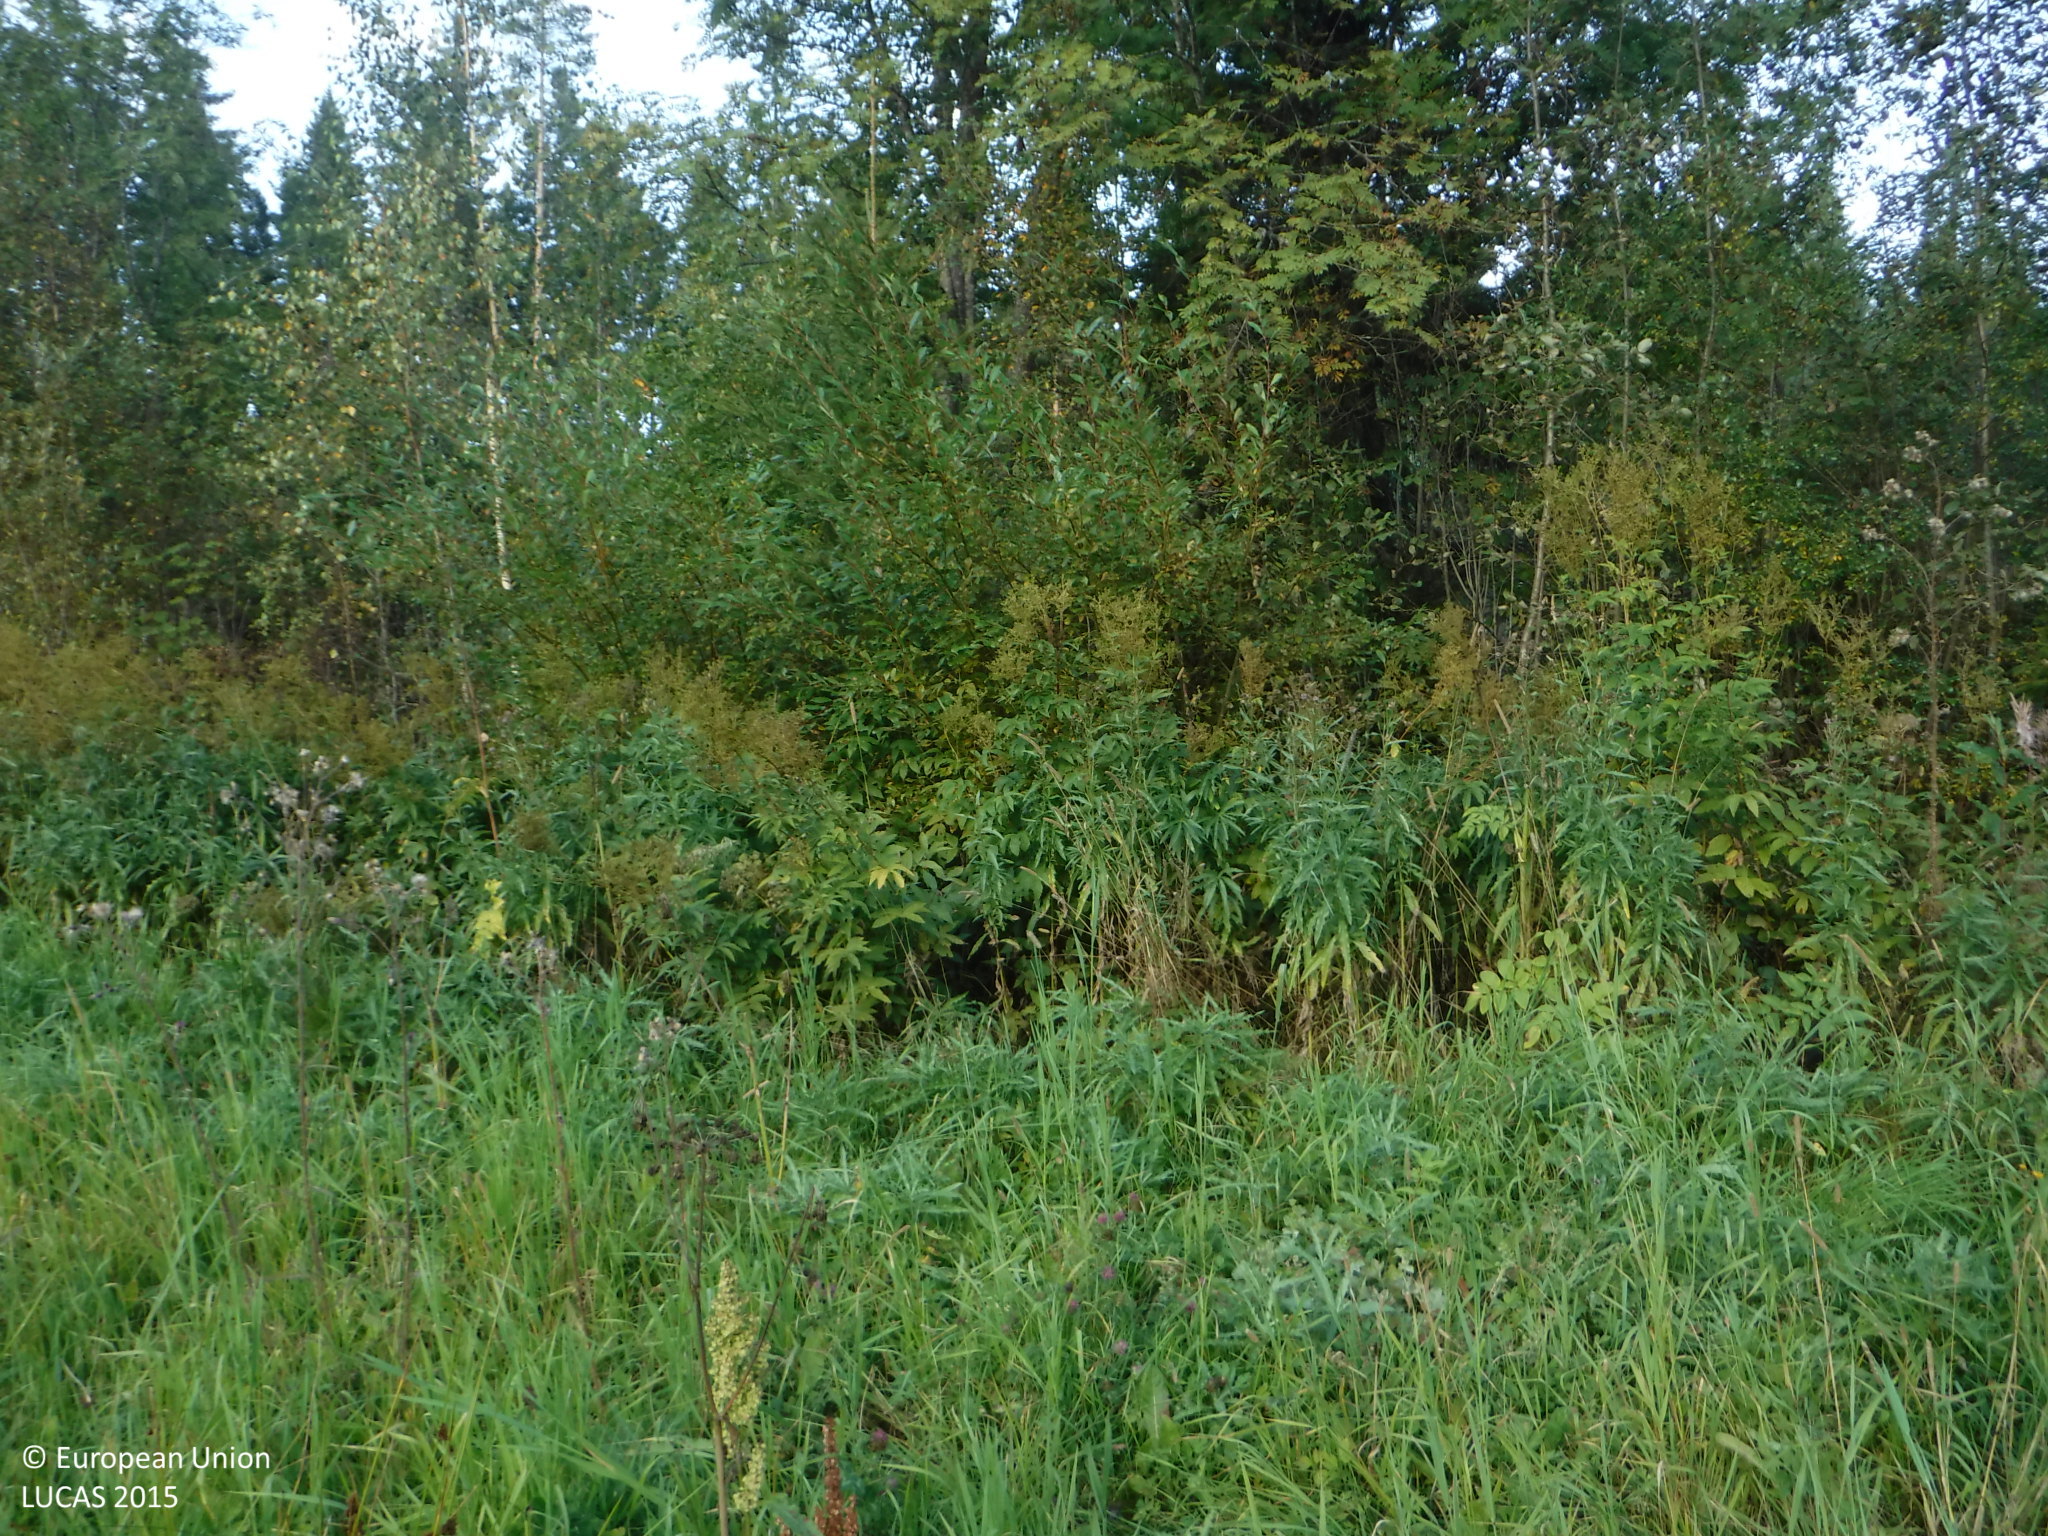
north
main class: Grassland
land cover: Grassland without tree/shrub cover
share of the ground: > 75 %
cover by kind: herbaceous plants 100 %
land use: Agriculture (excluding fallow land and kitchen gardens)
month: September
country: FI
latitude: 61.7686
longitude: 22.3966
